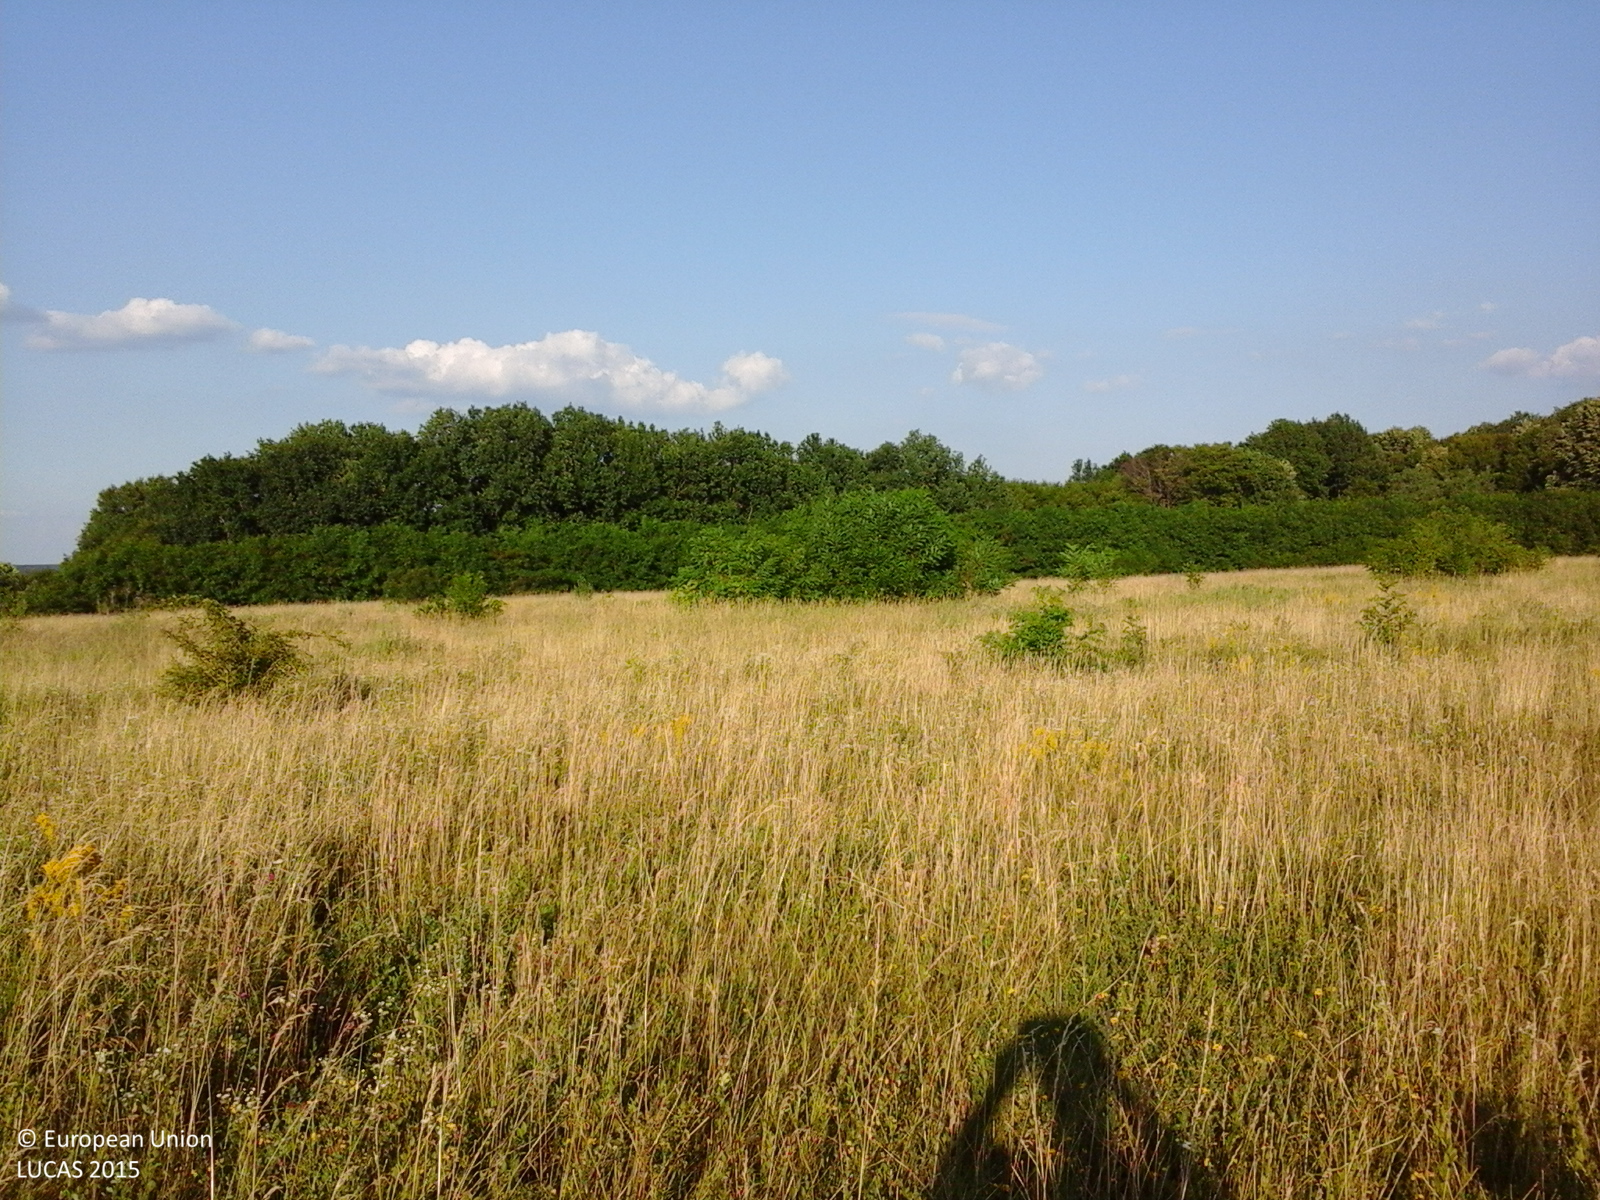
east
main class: Grassland
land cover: Grassland without tree/shrub cover
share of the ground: > 75 %
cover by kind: herbaceous plants 100 %
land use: Agriculture (excluding fallow land and kitchen gardens)
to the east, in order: Grassland without tree/shrub cover; Abandoned hedges; Fences; Lines of trees; Grassland without tree/shrub cover; Broadleaved woodland; Tracks; Broadleaved woodland
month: June
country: RO
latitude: 47.5951
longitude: 26.8429
